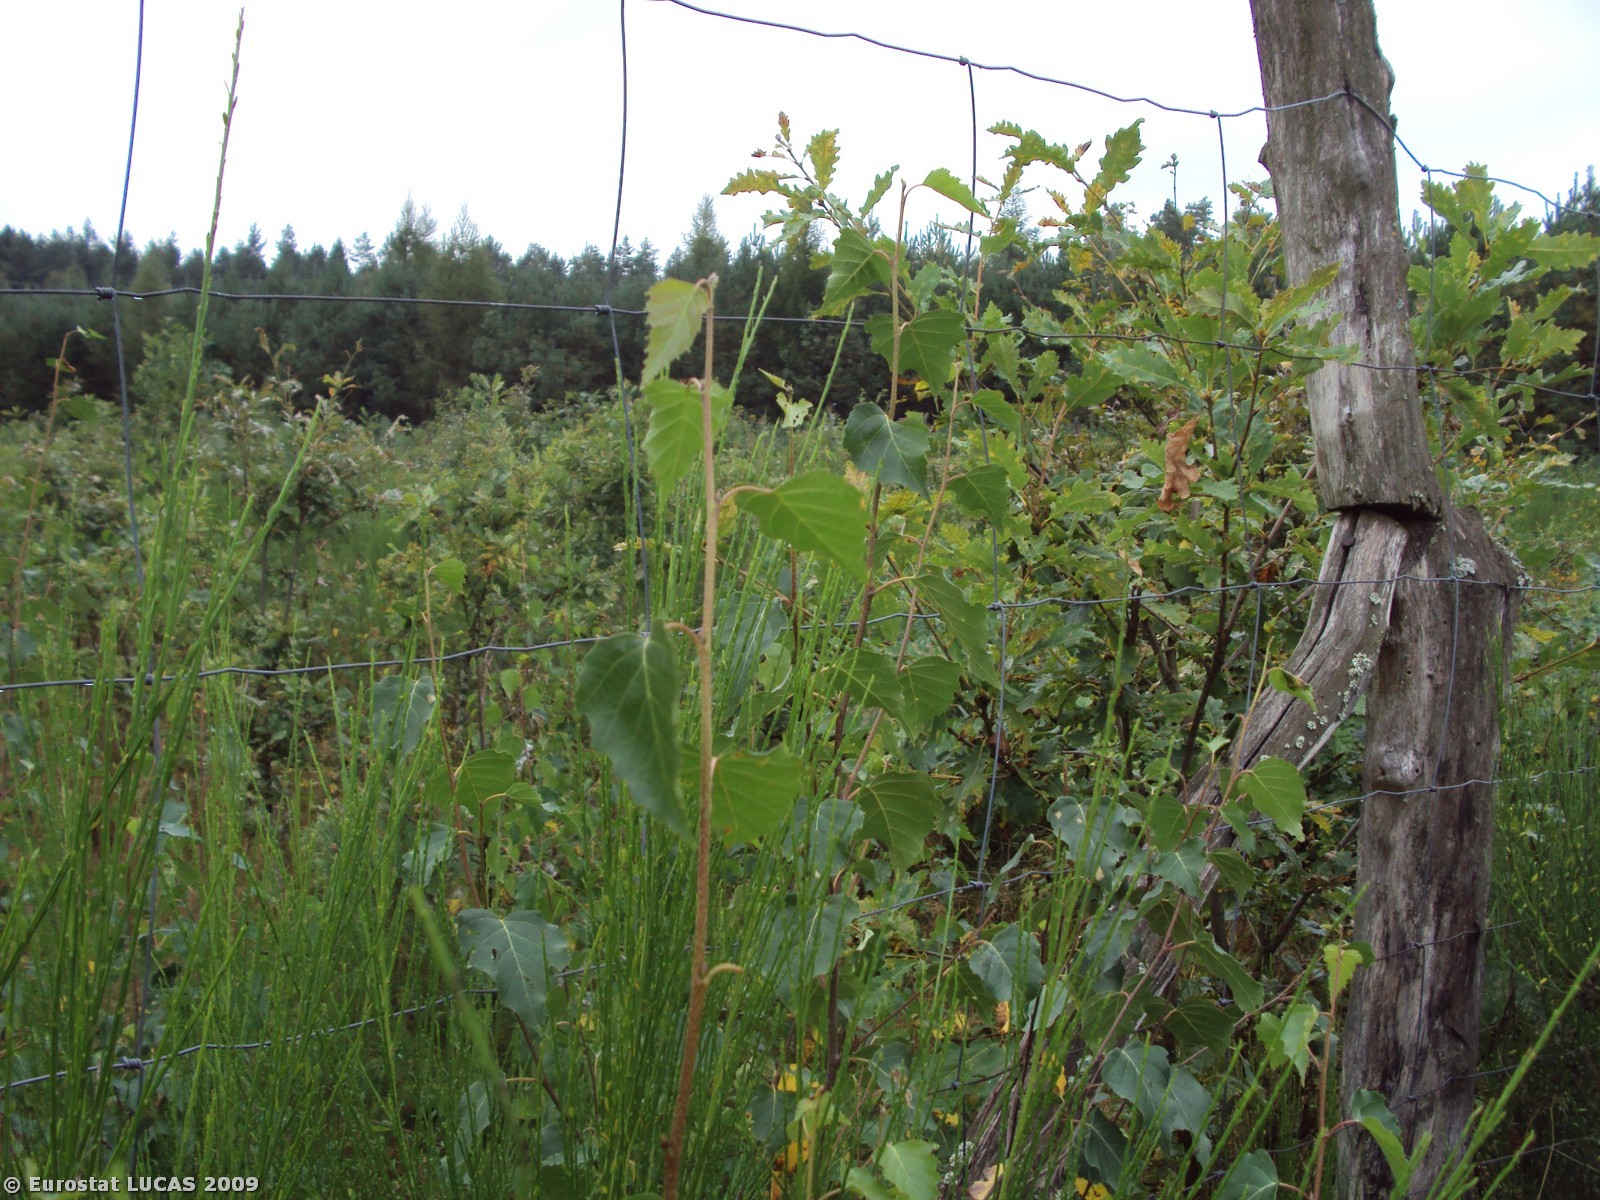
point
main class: Woodland
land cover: Broadleaved woodland
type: mesophytic deciduous forest
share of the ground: > 75 %
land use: Forestry
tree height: > 5 m
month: September
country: PL
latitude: 53.5642
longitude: 15.9080
